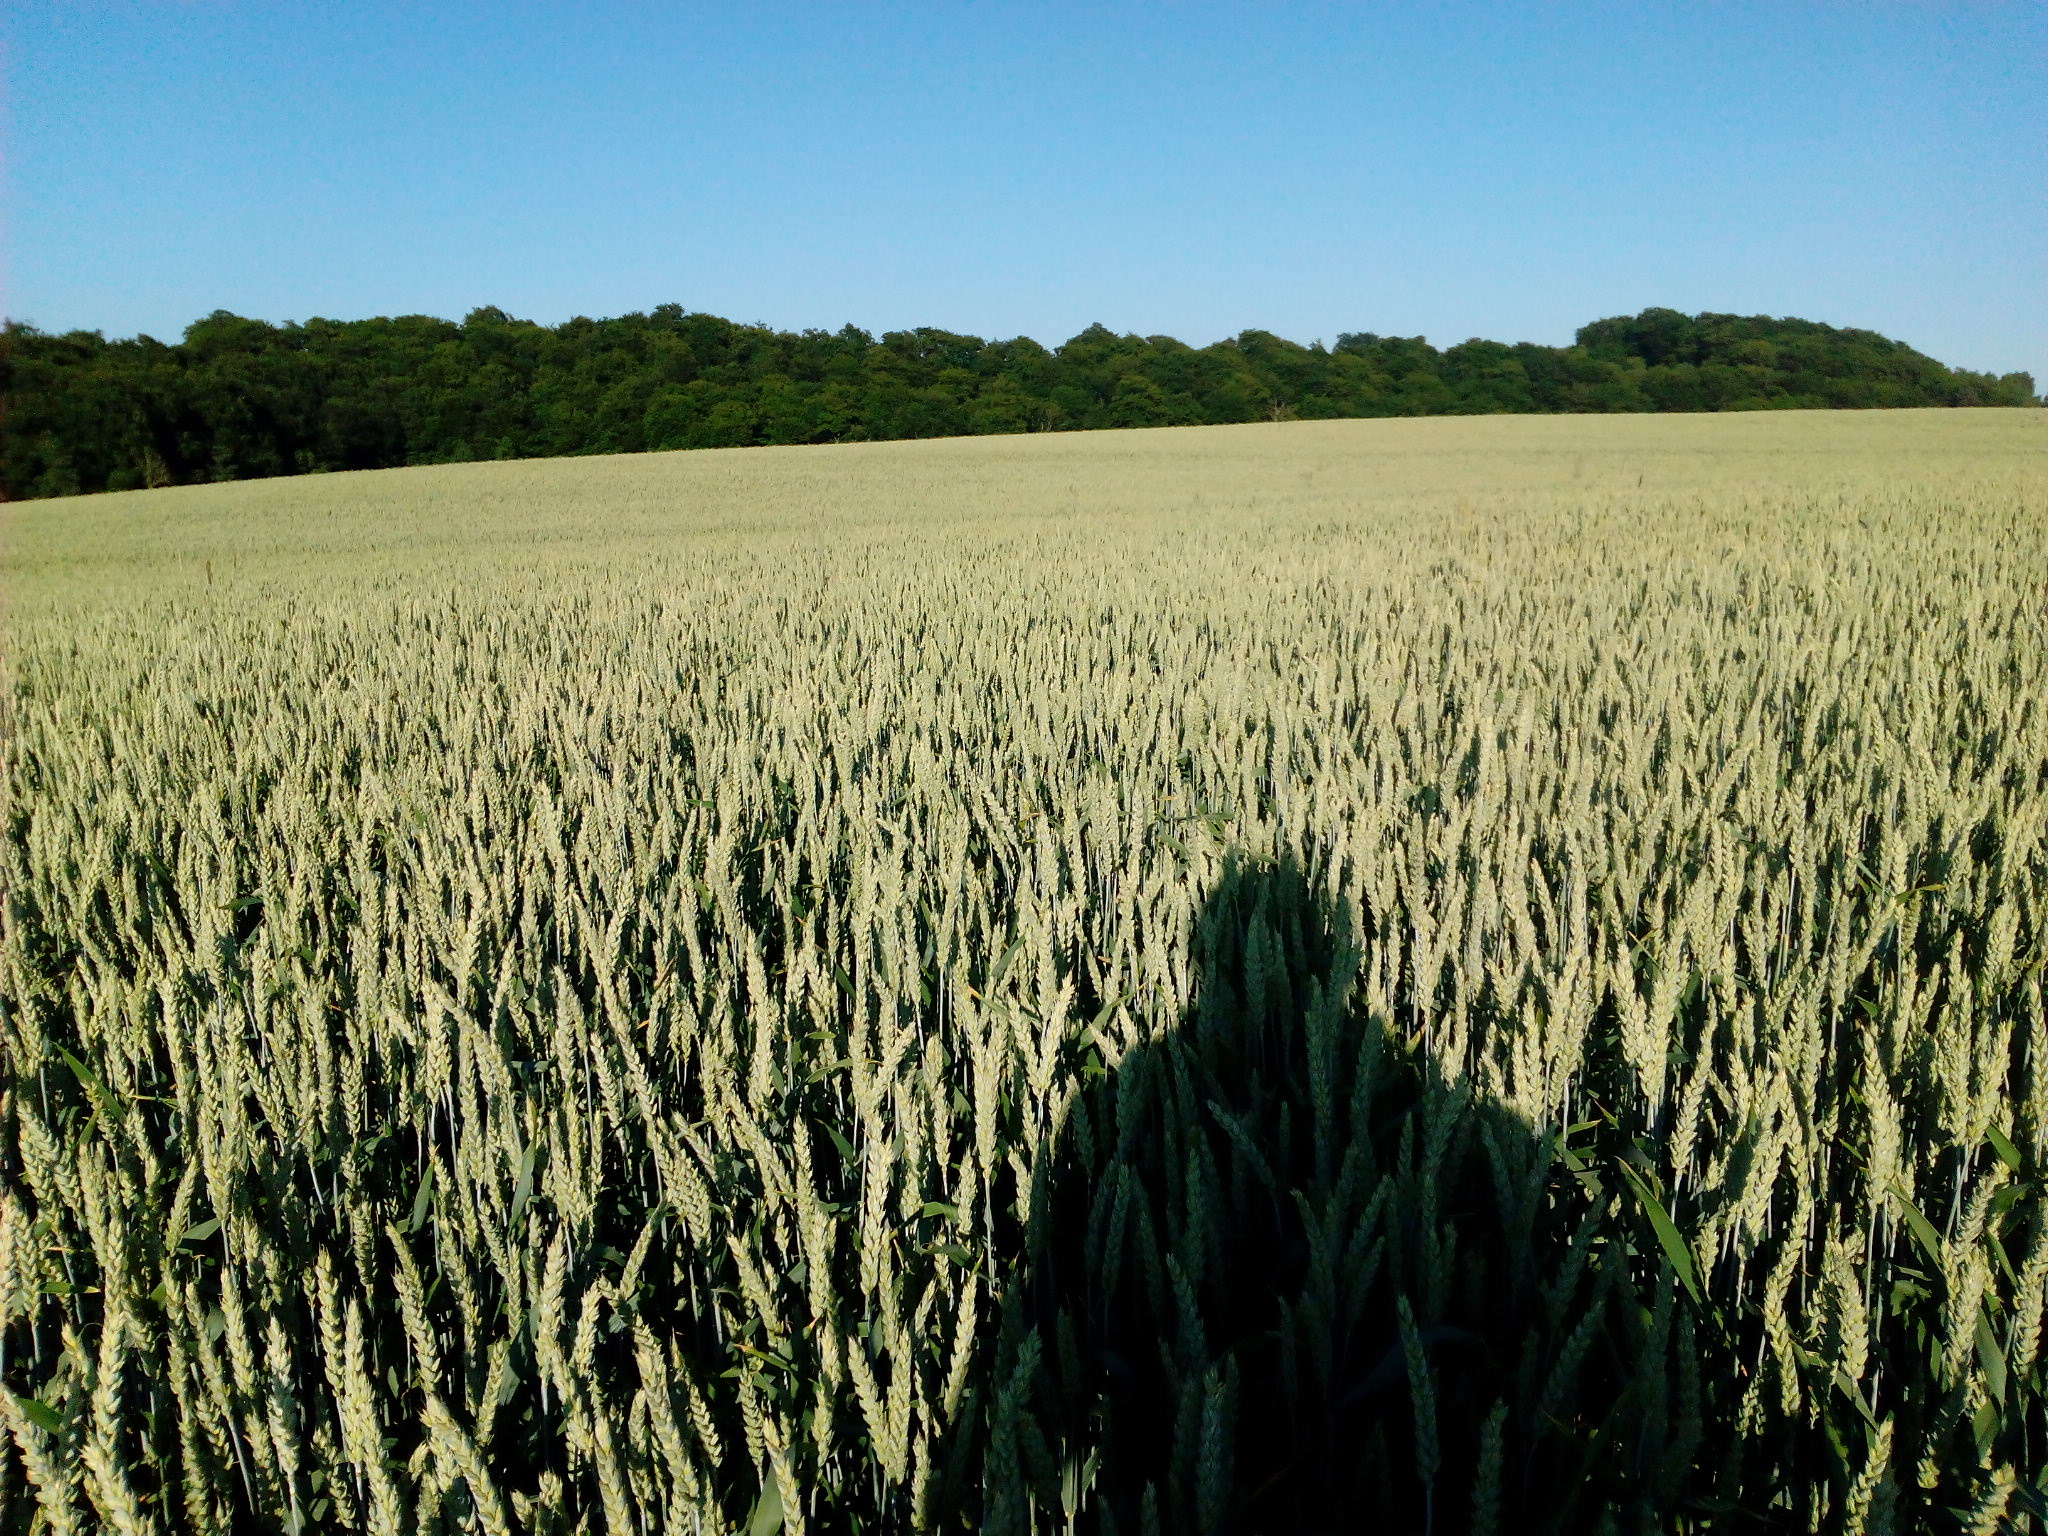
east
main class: Cropland
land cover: Common wheat
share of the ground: > 75 %
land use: Agriculture (excluding fallow land and kitchen gardens)
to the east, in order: Common wheat; Shruby margins
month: July
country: DE
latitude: 53.4315
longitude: 13.2055
